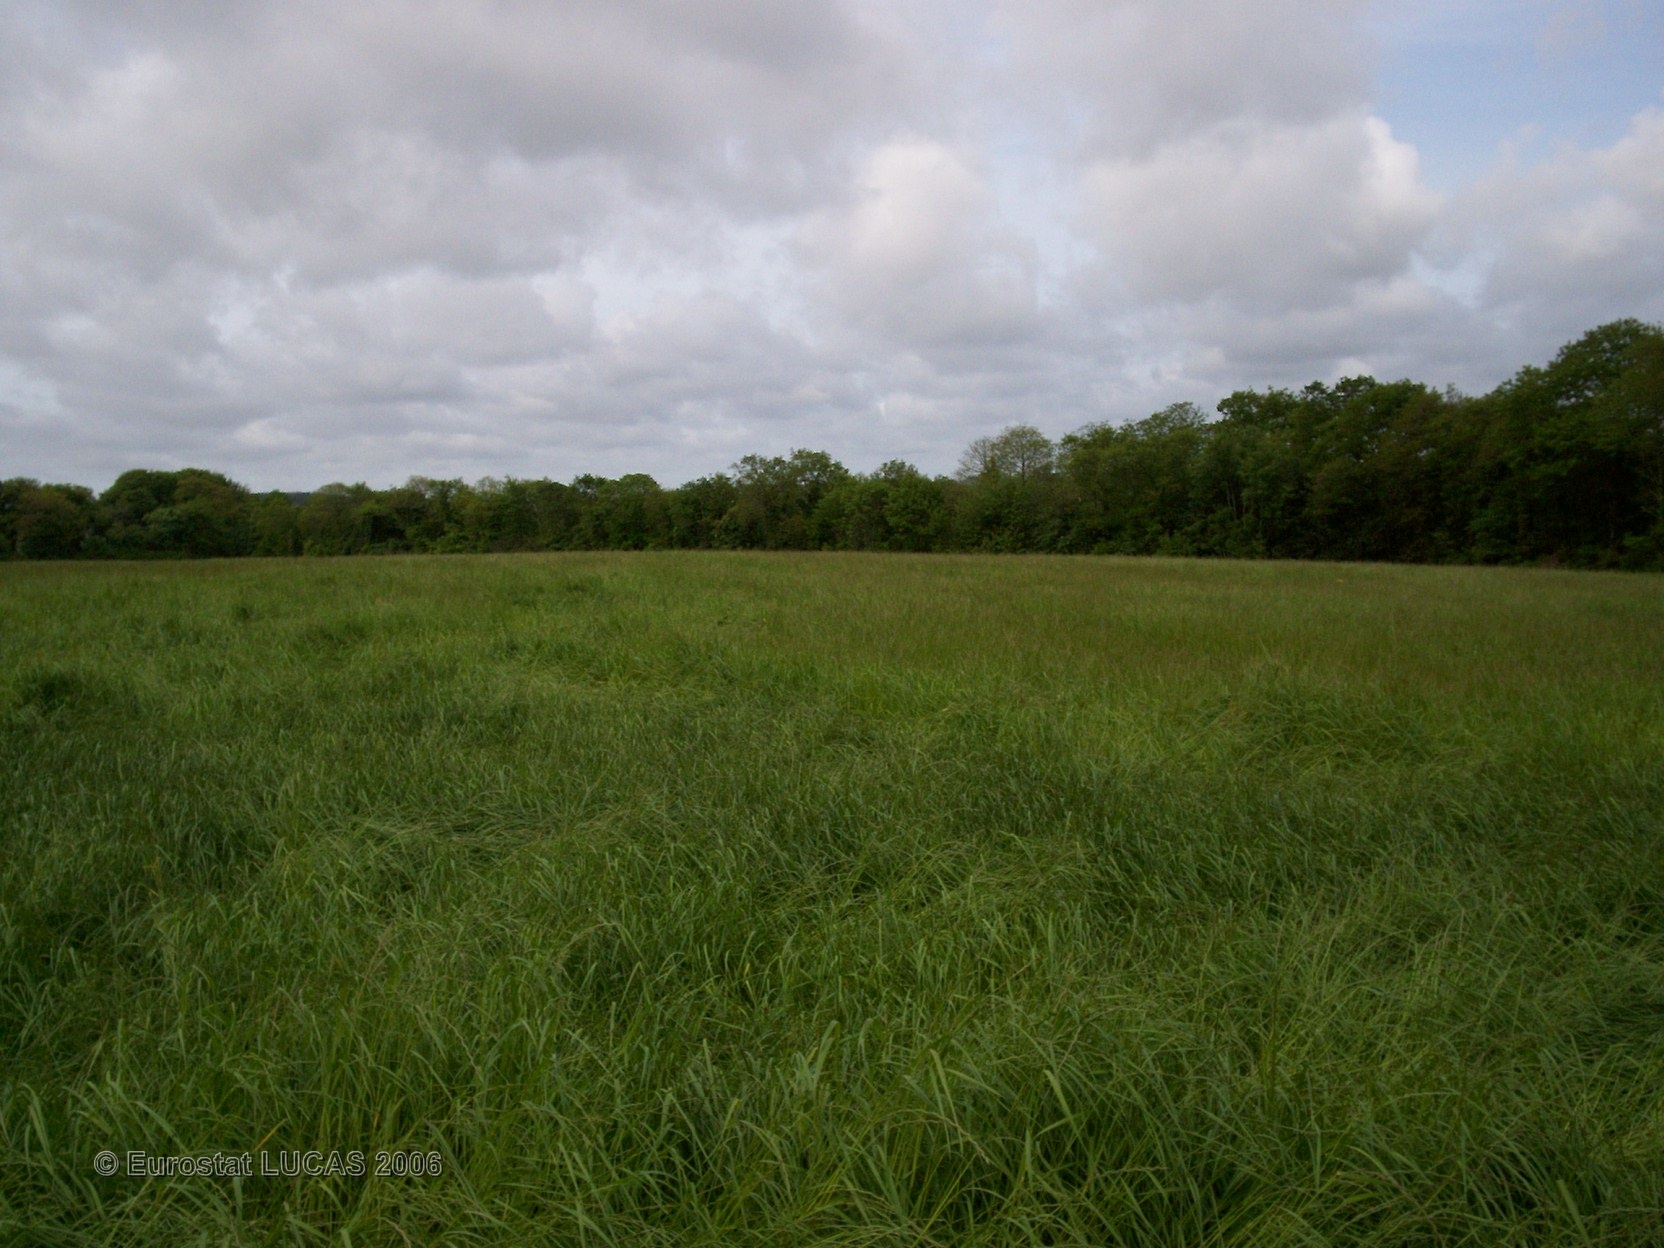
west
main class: Grassland
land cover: Grassland without tree/shrub cover
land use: Agriculture (excluding fallow land and kitchen gardens)
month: May
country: FR
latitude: 47.9771
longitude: -3.8960
